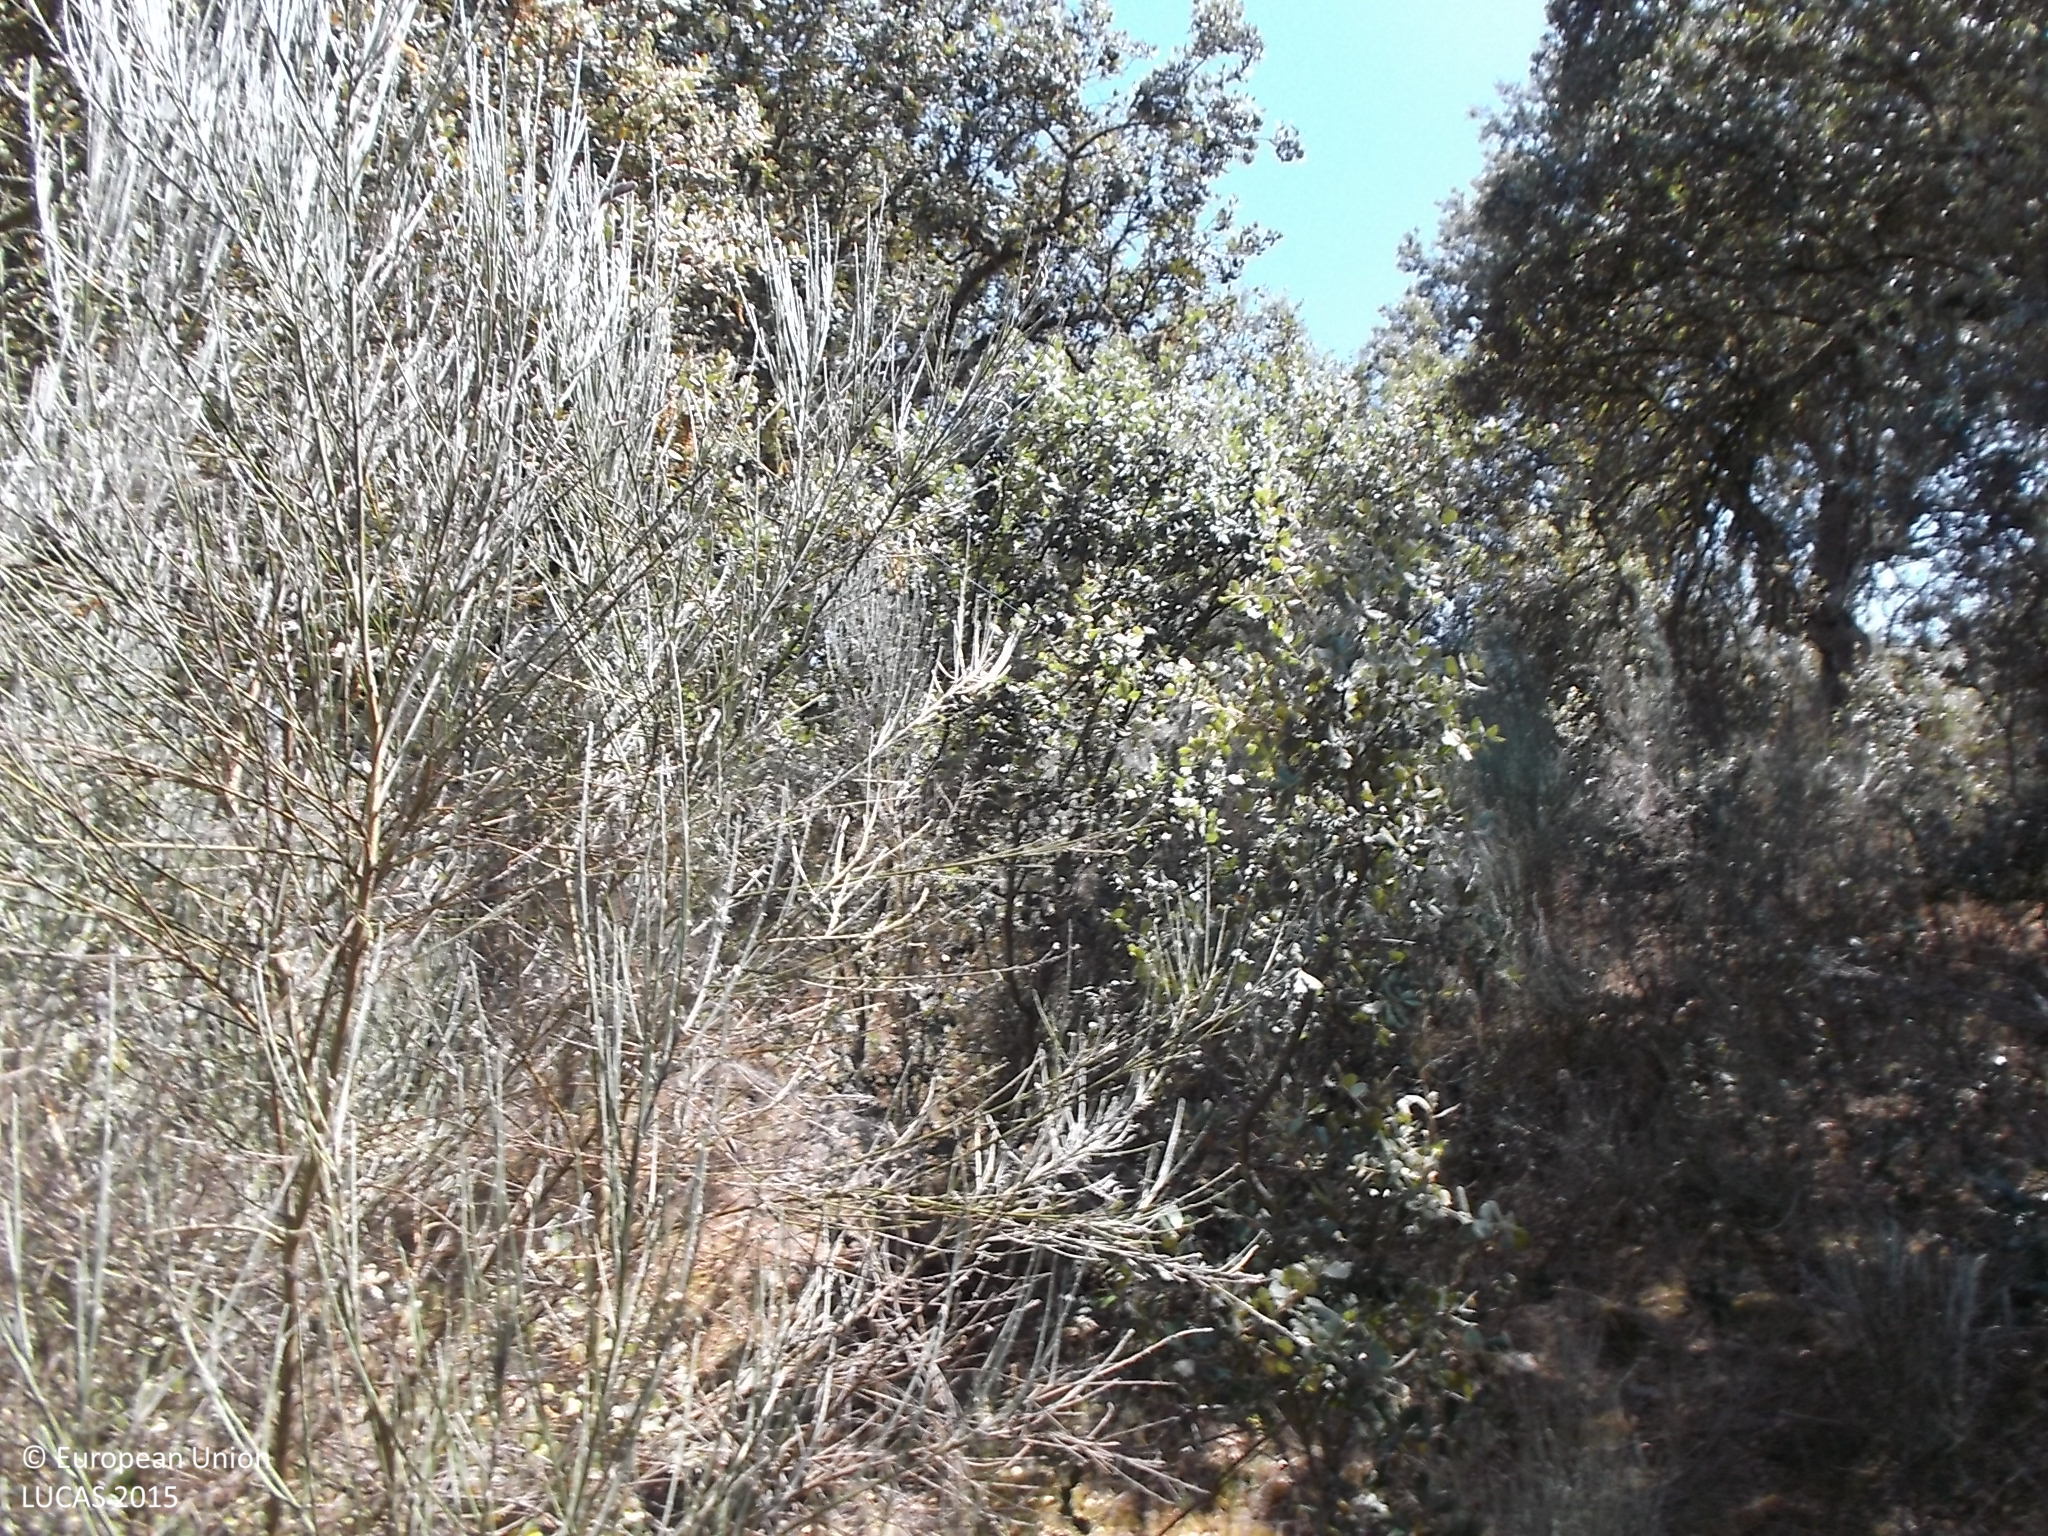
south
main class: Woodland
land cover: Broadleaved woodland
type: broadleaved evergreen forest
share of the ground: 50 - 75 %
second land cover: Shrubland without tree cover
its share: 50 - 75 %
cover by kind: broadleaved forest trees 60 %, shrubs 40 %
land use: Forestry
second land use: Agriculture (excluding fallow land and kitchen gardens)
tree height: < 5 m
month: July
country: ES
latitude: 40.7269
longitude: -6.7796
